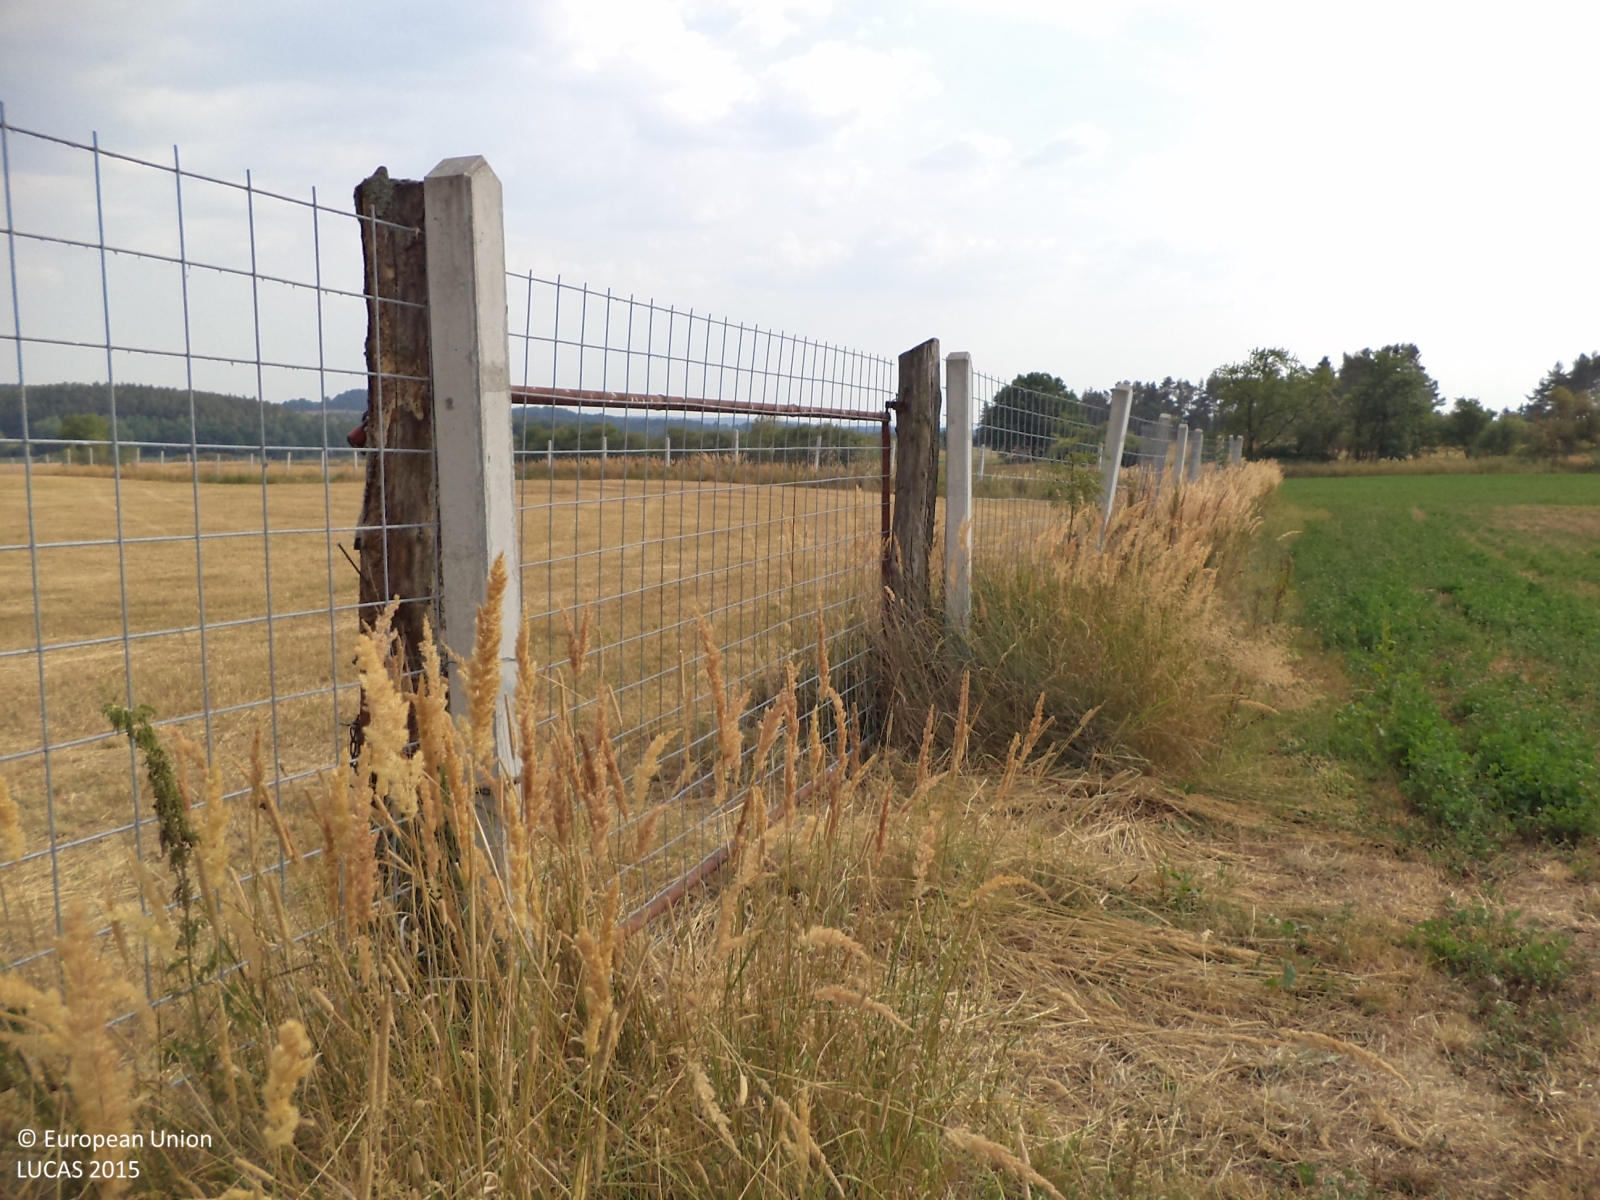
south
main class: Grassland
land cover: Grassland without tree/shrub cover
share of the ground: > 75 %
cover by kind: herbaceous plants 100 %
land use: Agriculture (excluding fallow land and kitchen gardens)
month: August
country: CZ
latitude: 49.5090
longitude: 14.2962
